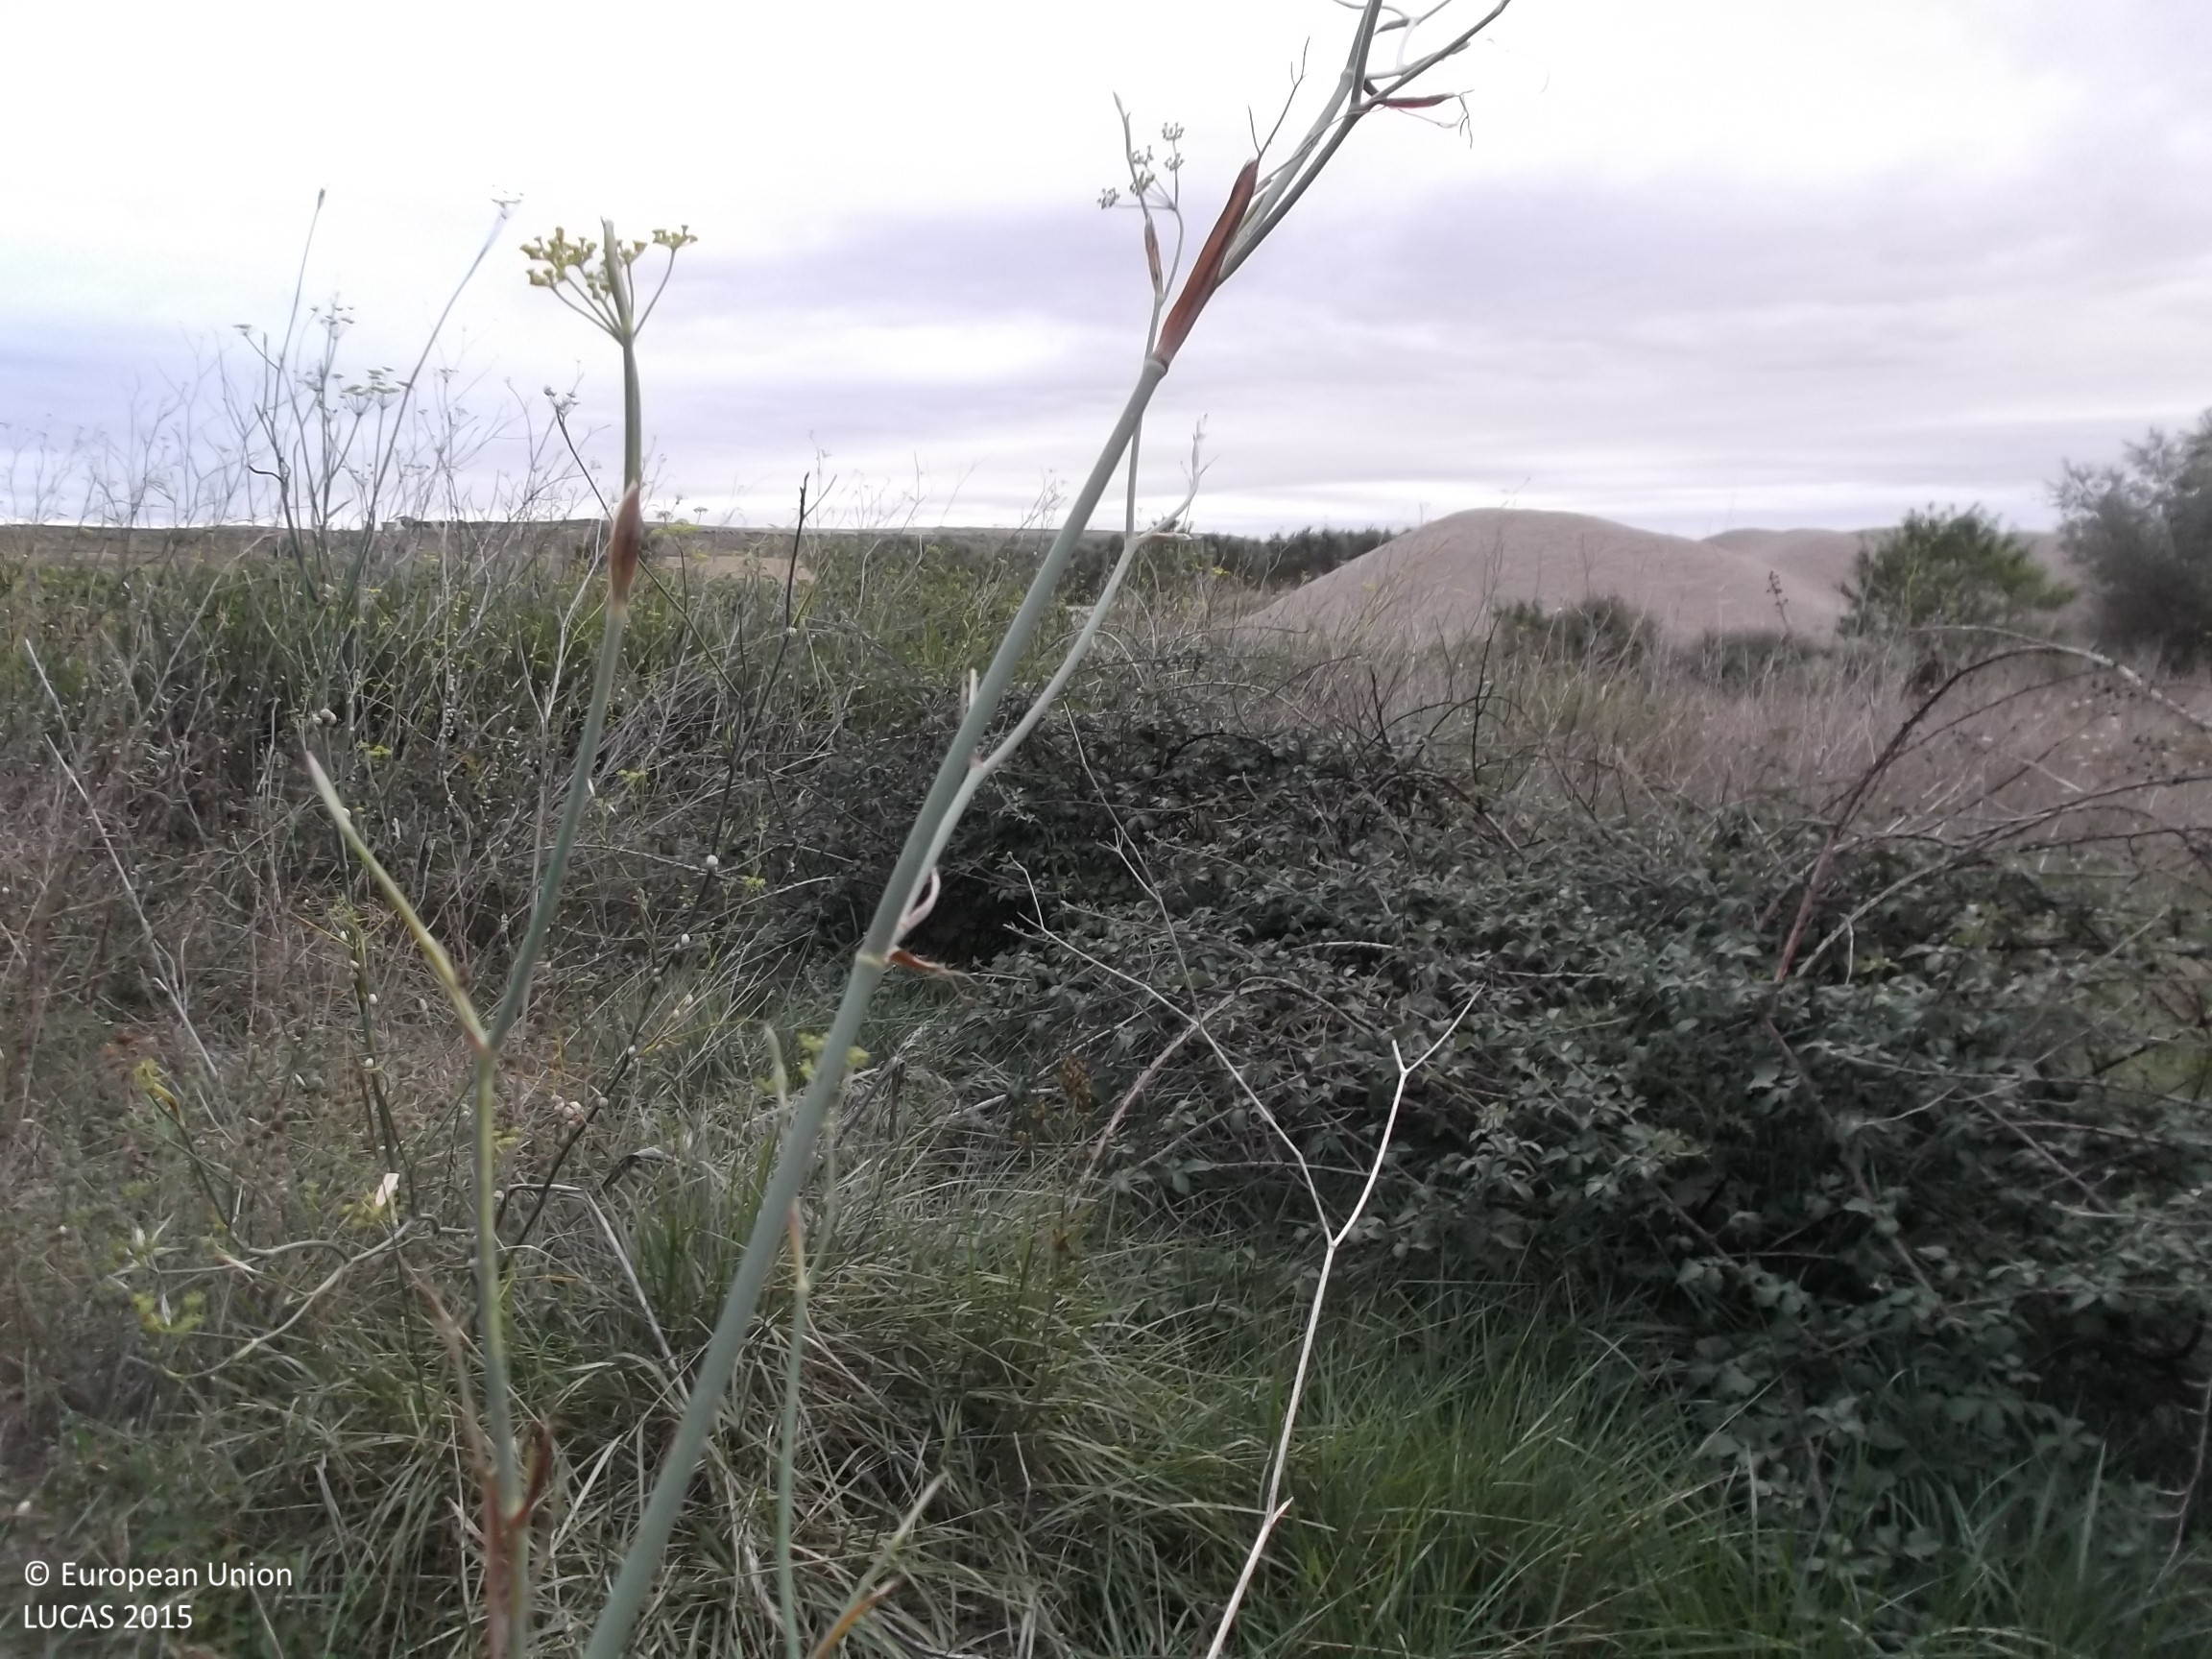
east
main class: Shrubland
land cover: Shrubland without tree cover
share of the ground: 50 - 75 %
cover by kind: shrubs 50 %, herbaceous plants 50 %
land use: Semi-natural and natural areas not in use
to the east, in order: Shrubland without tree cover; Tracks; Shrubland without tree cover; Tracks; Vineyards; Tracks; Grass margins; Single bushes/trees; Grass margins; Tracks; Olive groves; Other bare soil; Vineyards; Spontaneously vegetated surfaces; Olive groves; Common wheat
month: July
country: ES
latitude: 42.4770
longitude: -2.3662
